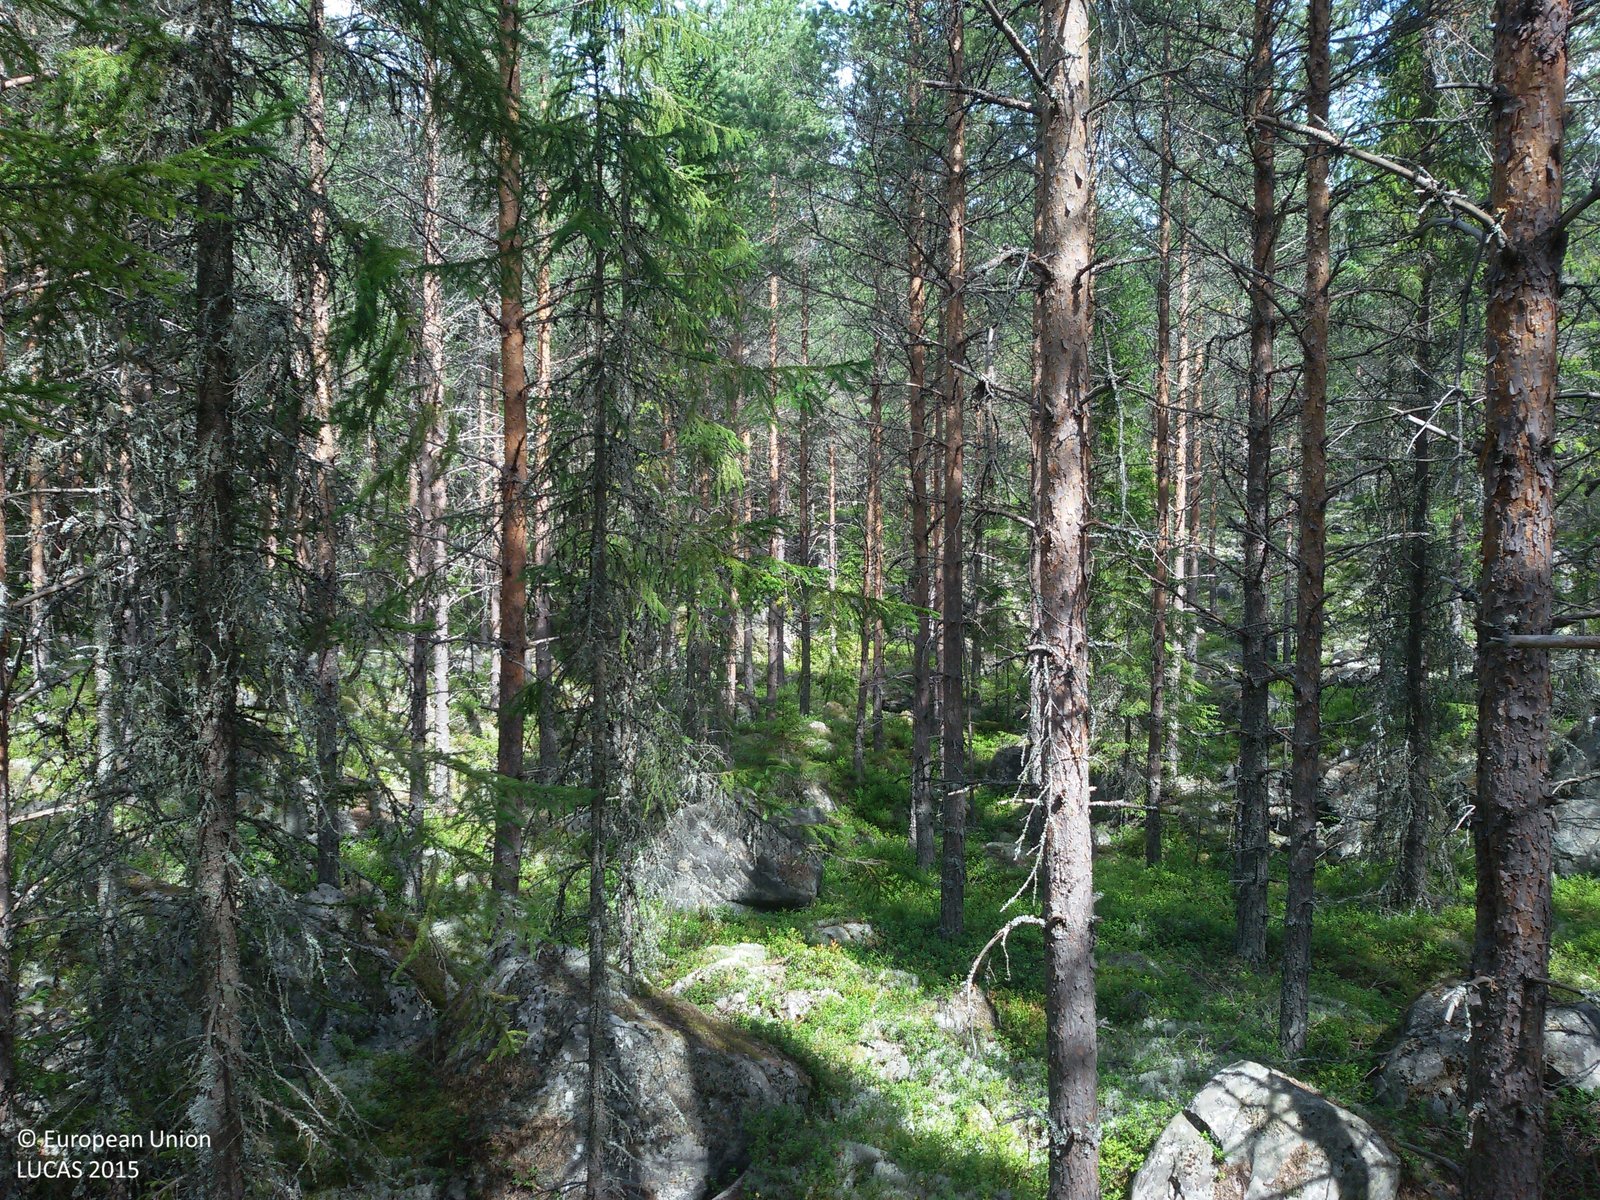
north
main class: Woodland
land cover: Pine dominated coniferous woodland
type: boreal forest
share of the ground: > 75 %
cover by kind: coniferous forest trees 80 %, shrubs 15 %, lichens and mosses 5 %
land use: Forestry
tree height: > 5 m
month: July
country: SE
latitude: 60.6362
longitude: 15.4170
